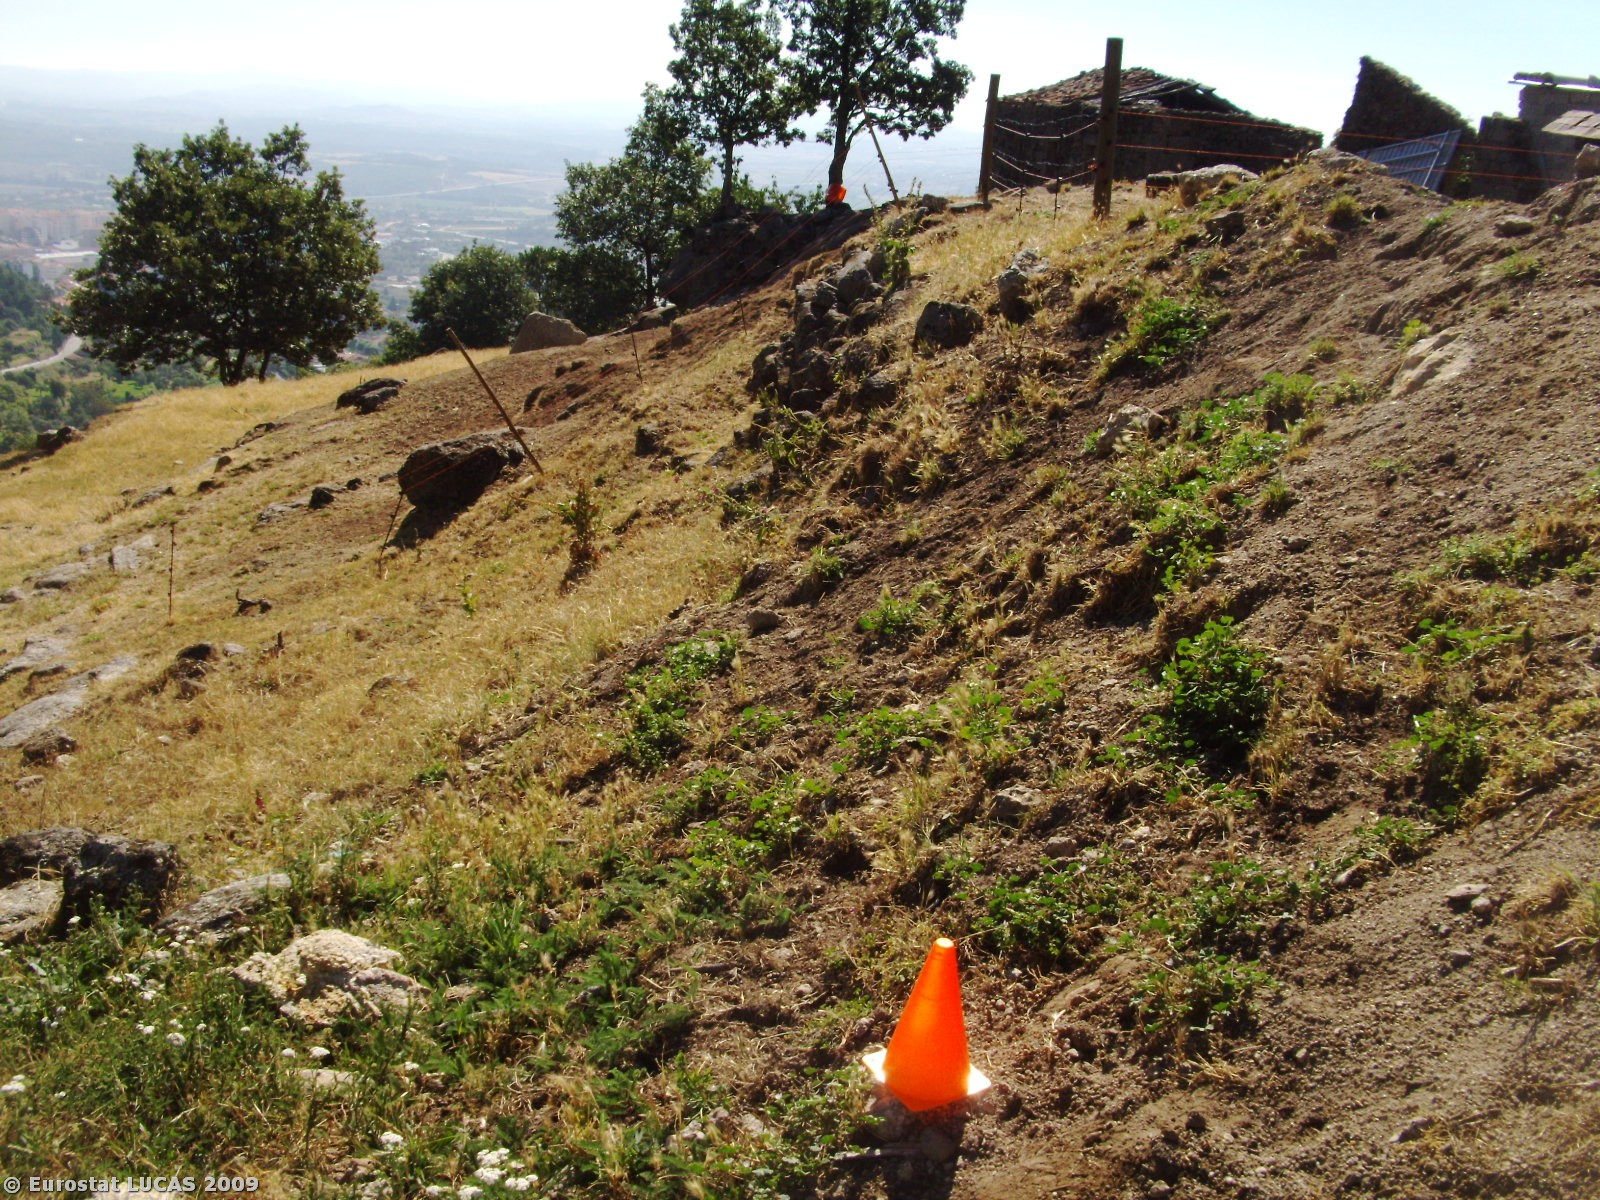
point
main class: Grassland
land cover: Spontaneously vegetated surfaces
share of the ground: > 75 %
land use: Fallow land
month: July
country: PT
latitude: 40.2640
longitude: -7.5221
